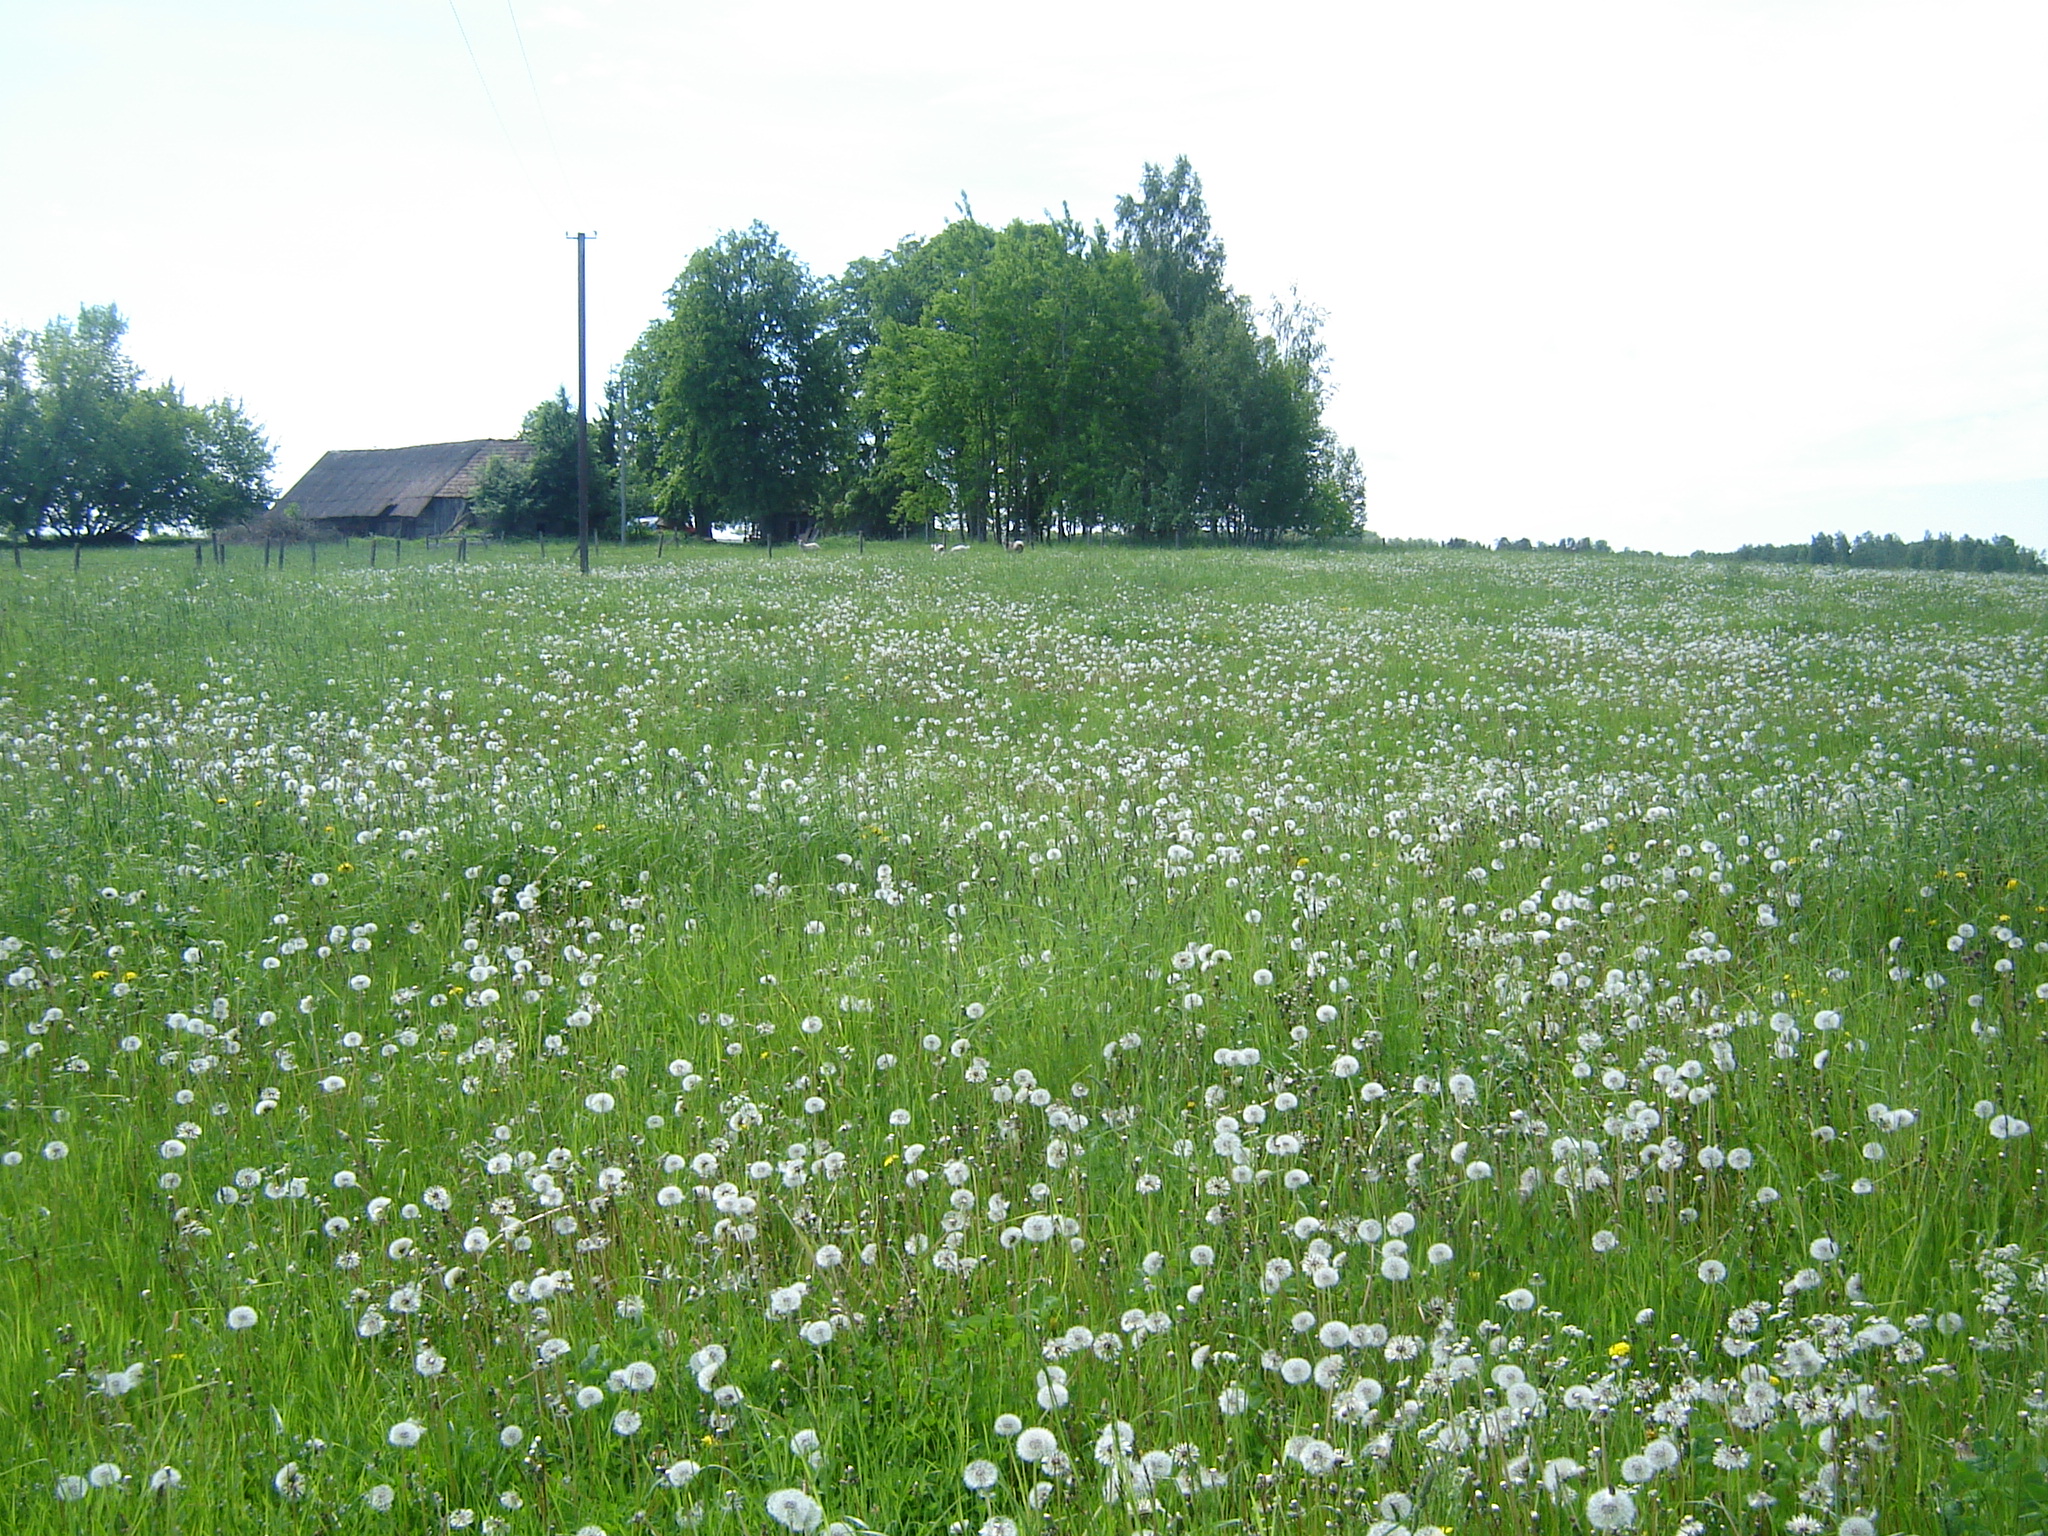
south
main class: Grassland
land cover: Grassland without tree/shrub cover
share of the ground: > 75 %
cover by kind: herbaceous plants 100 %
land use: Agriculture (excluding fallow land and kitchen gardens)
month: May
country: LT
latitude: 55.8321
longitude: 25.1374
